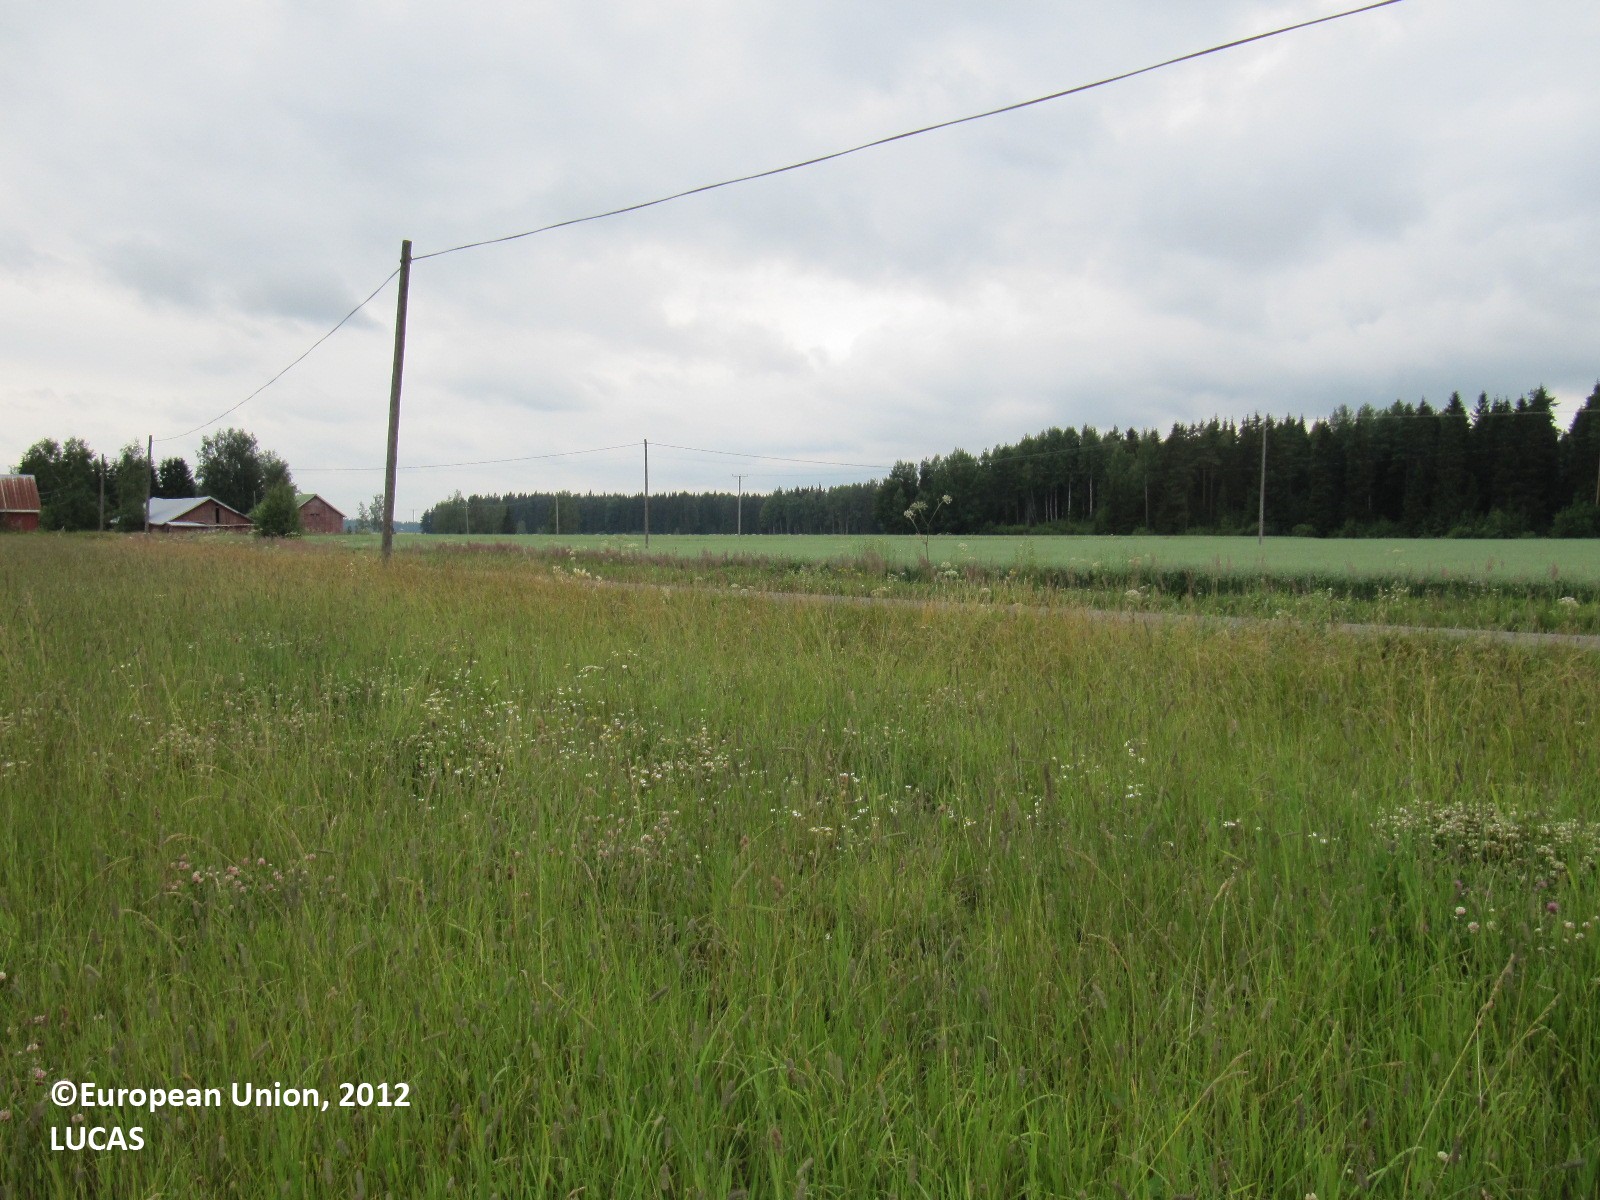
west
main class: Cropland
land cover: Temporary grasslands
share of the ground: > 75 %
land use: Agriculture (excluding fallow land and kitchen gardens)
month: July
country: FI
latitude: 60.7328
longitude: 23.3400
